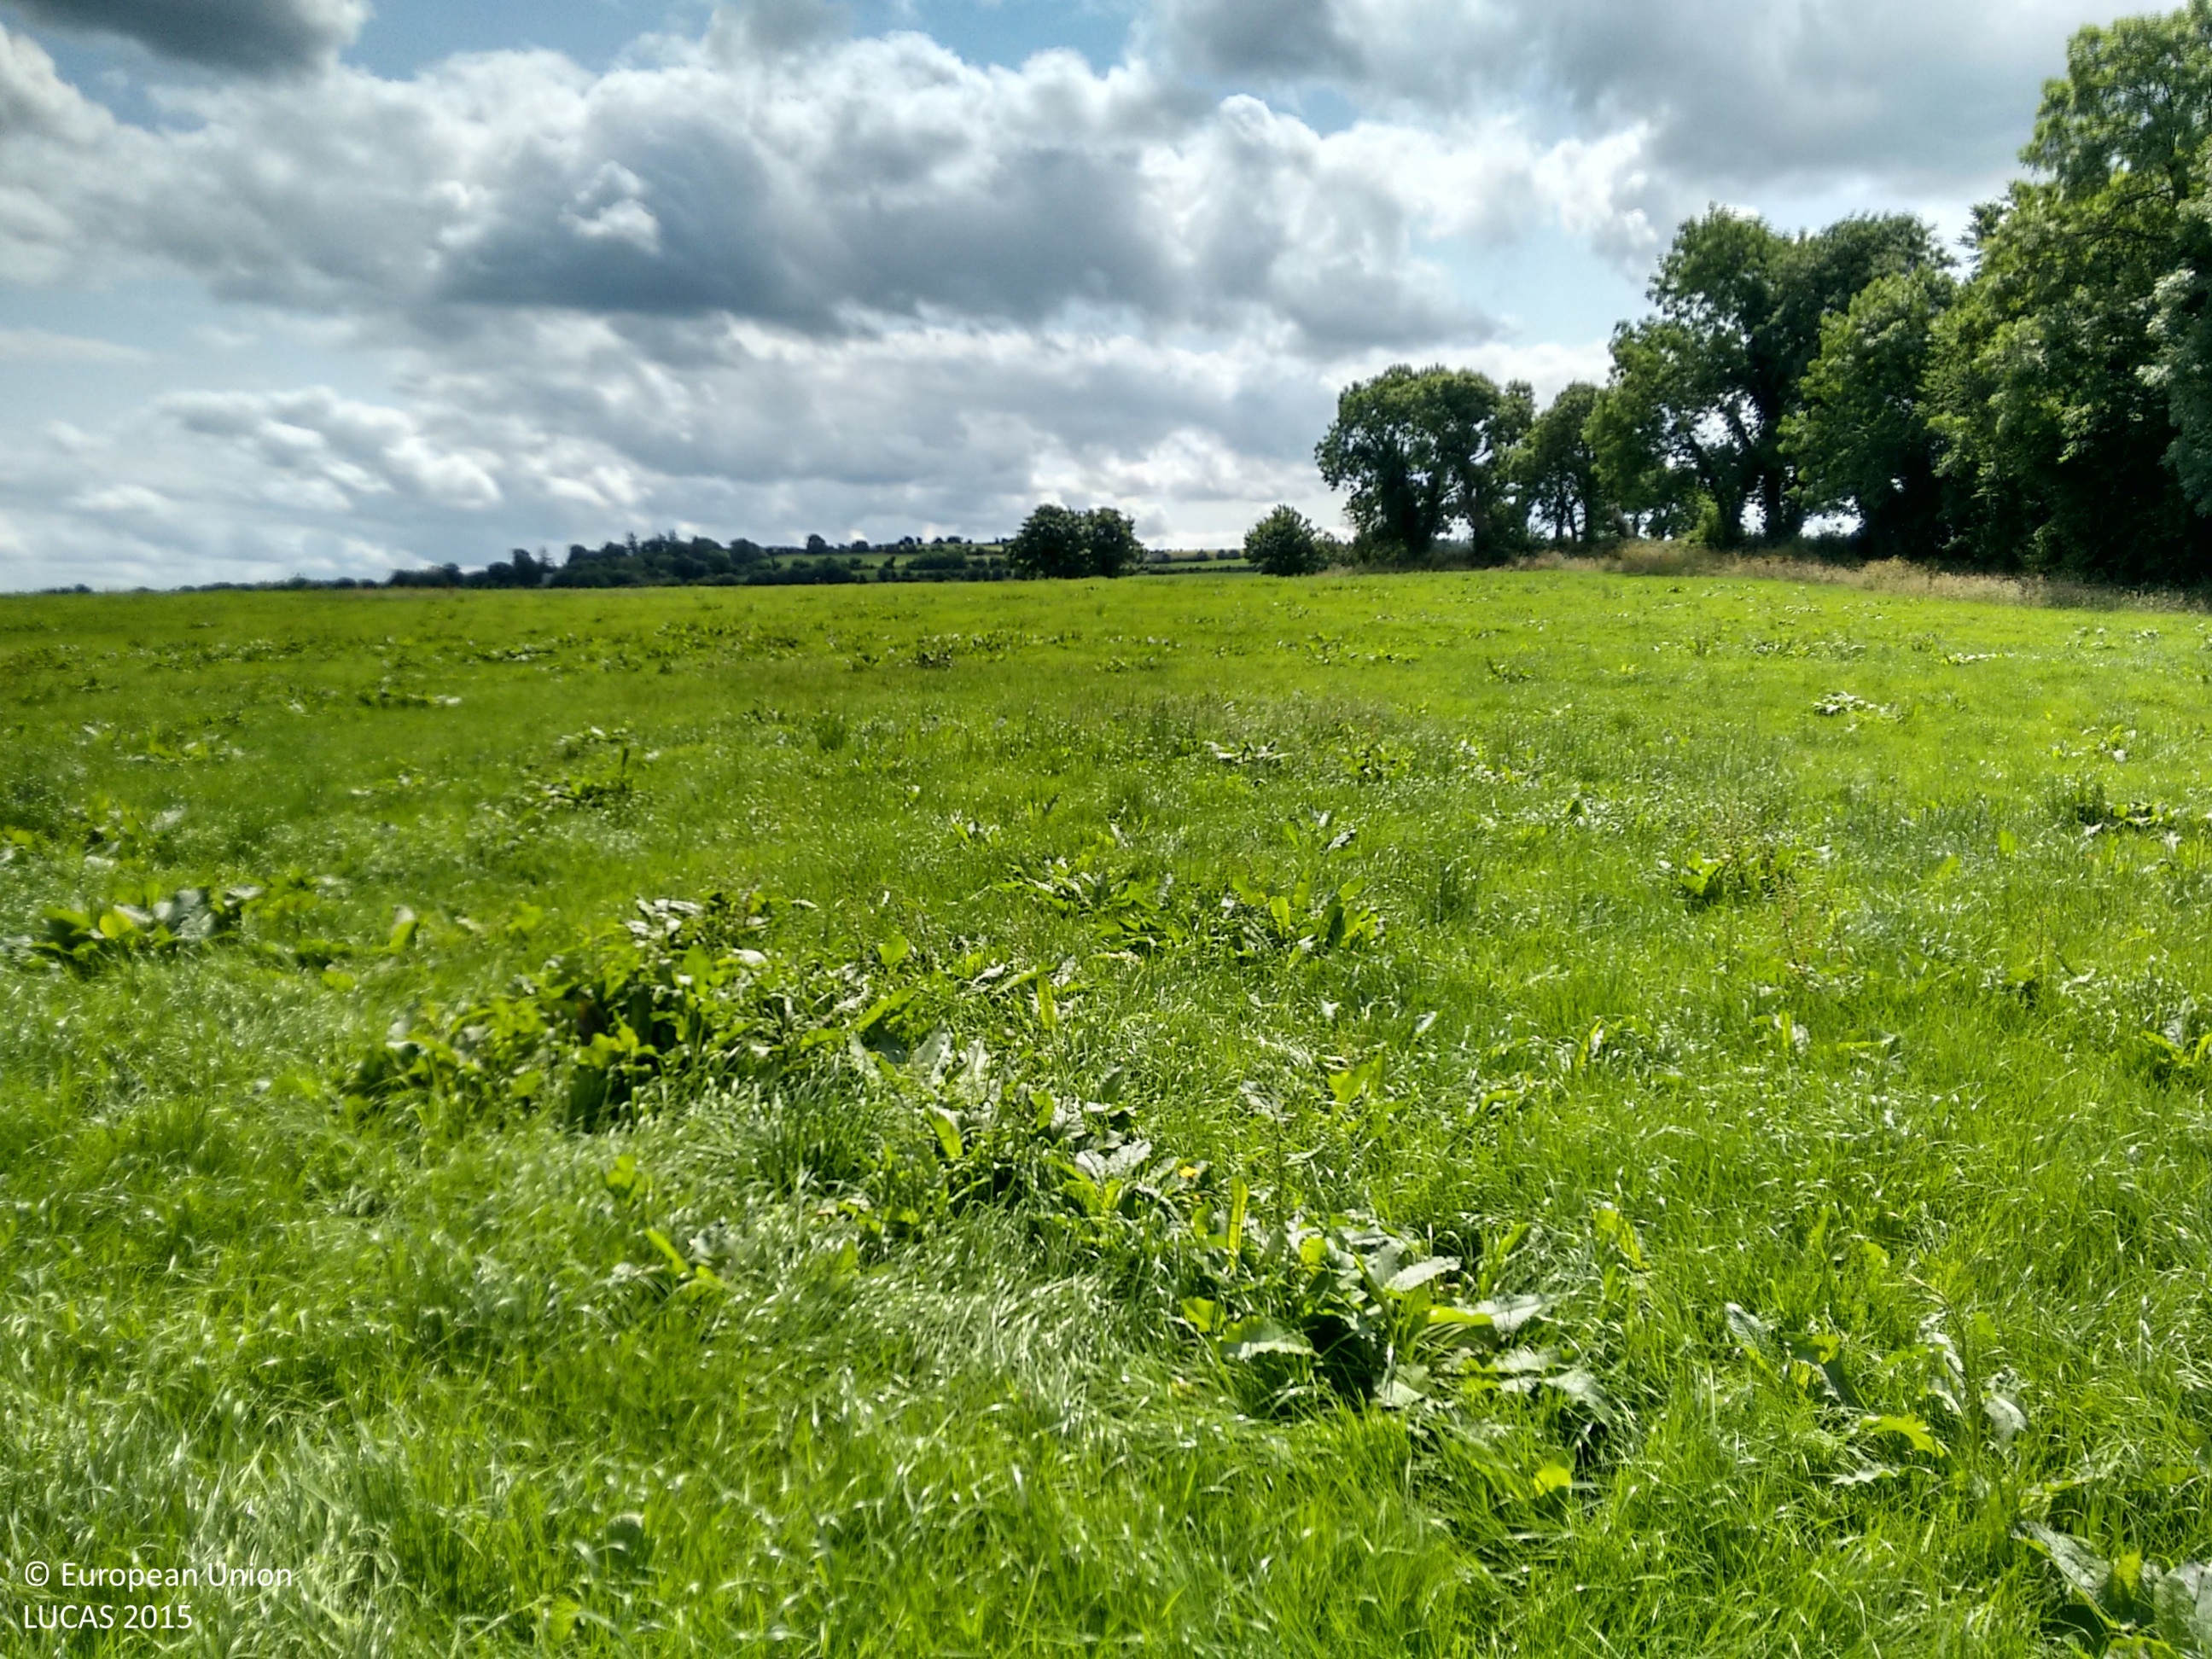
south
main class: Woodland
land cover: Other mixed woodland
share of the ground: > 75 %
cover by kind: herbaceous plants 40 %, coniferous forest trees 30 %, broadleaved forest trees 30 %
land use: Agriculture (excluding fallow land and kitchen gardens)
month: July
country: IE
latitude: 52.5608
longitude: -7.5829
